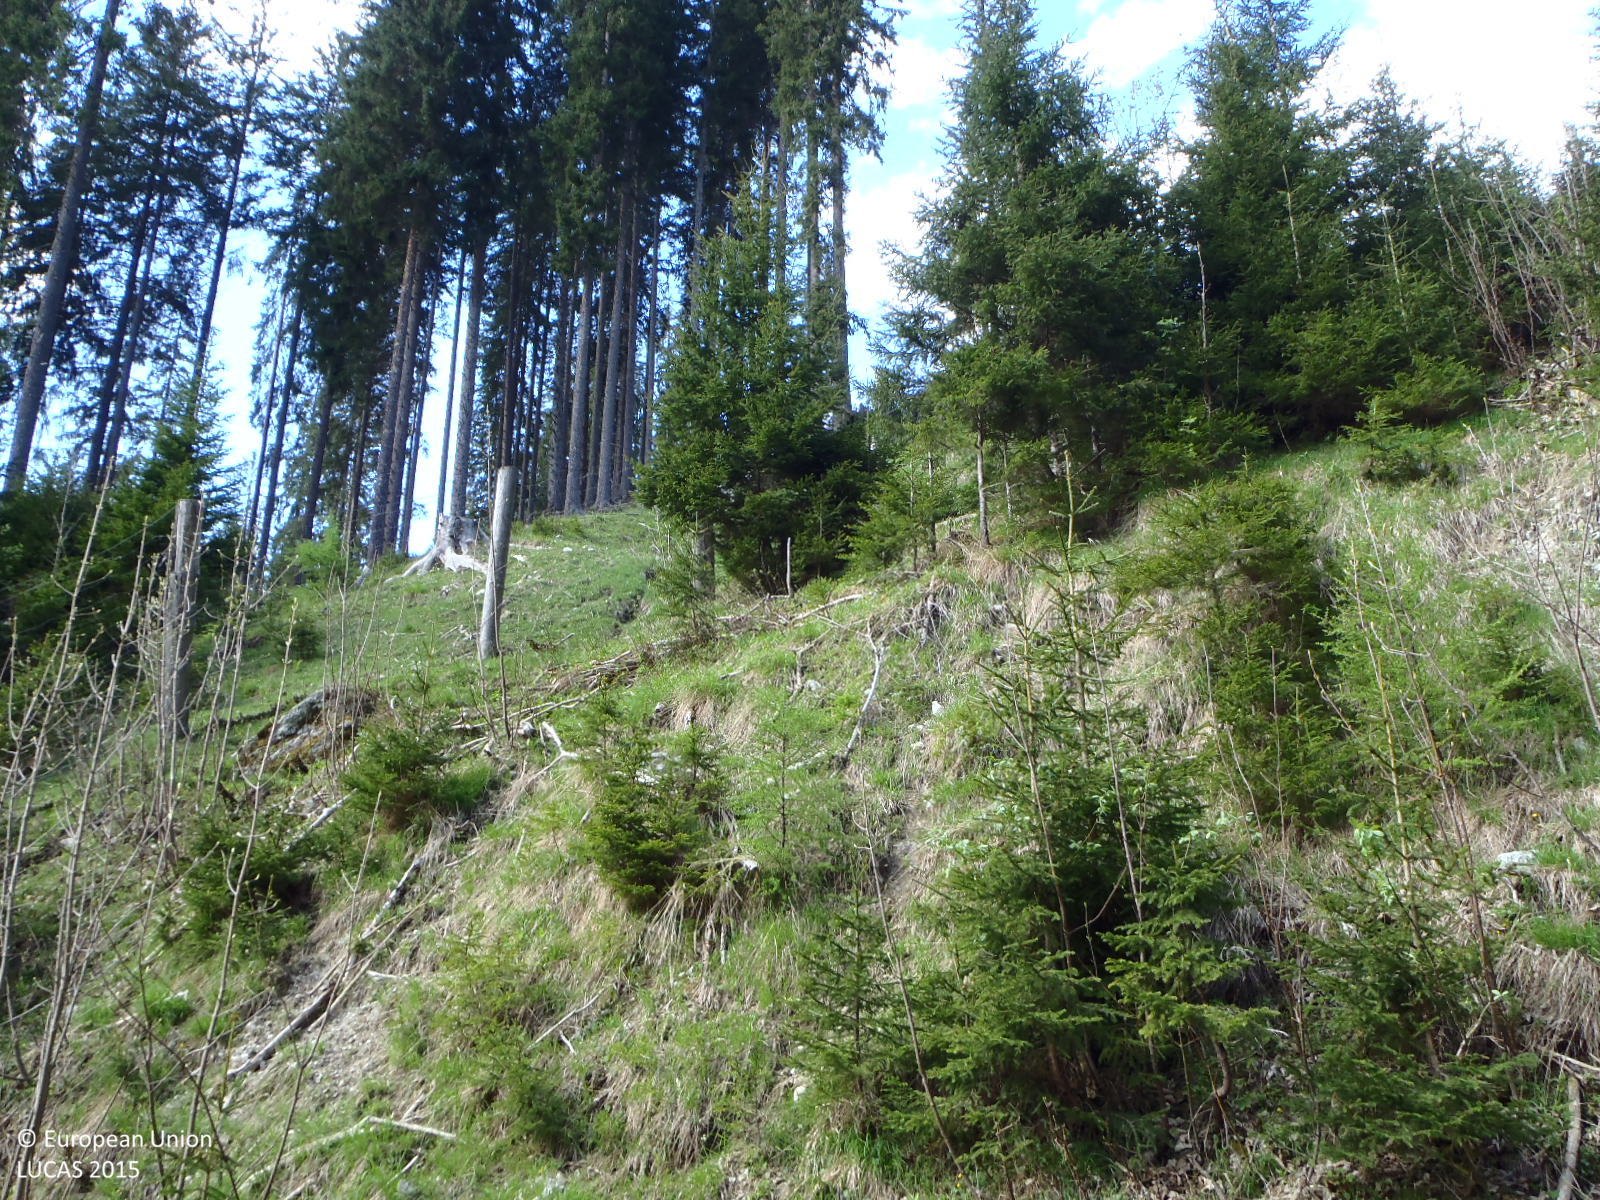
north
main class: Woodland
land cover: Spruce dominated coniferous woodland
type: alpine coniferous forest
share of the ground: 25 - 50 %
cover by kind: herbaceous plants 50 %, coniferous forest trees 40 %, shrubs 5 %, lichens and mosses 5 %
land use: Forestry
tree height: > 5 m
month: May
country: AT
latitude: 47.3229
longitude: 13.4514
